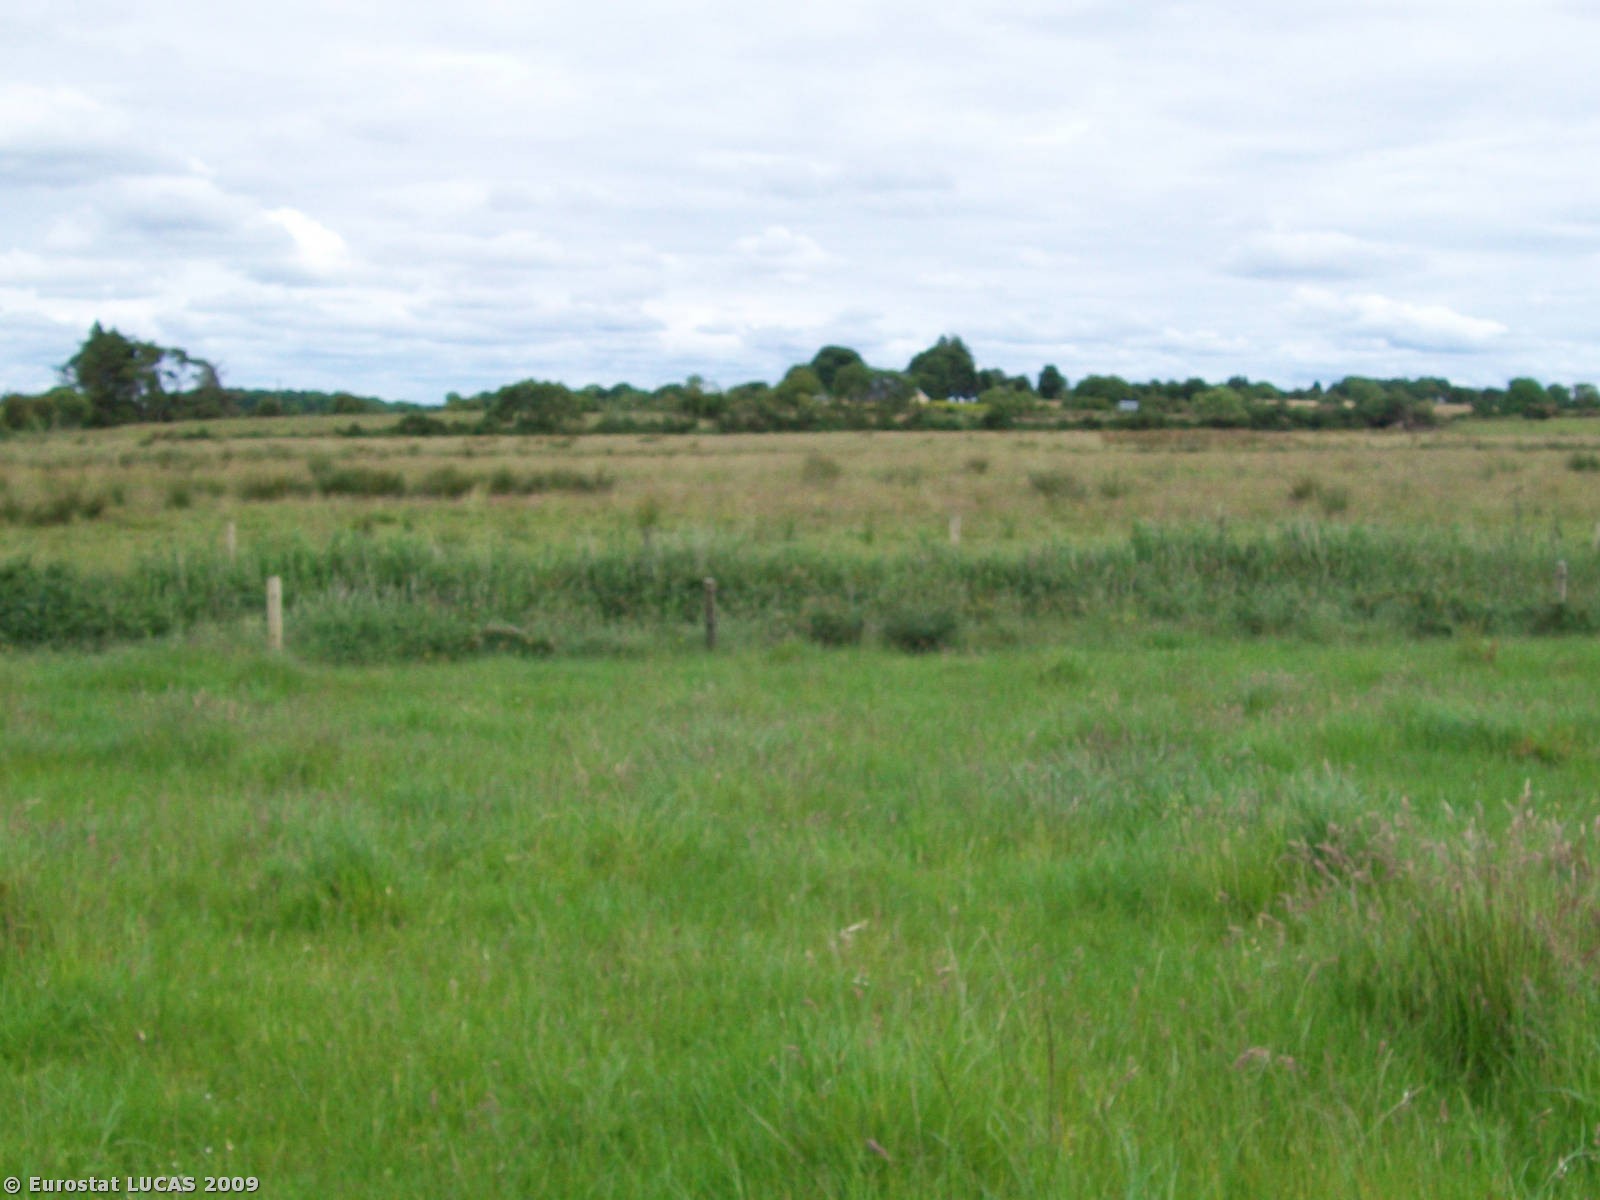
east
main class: Artificial land
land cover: Non built-up linear features
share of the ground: > 75 %
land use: Road transport
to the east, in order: Non built-up linear features; Grassland without tree/shrub cover; Fences; Ditches and canals; Fences; Grassland without tree/shrub cover; Fences; Rivers and streams; Fences; Grassland without tree/shrub cover; Fences; Grassland without tree/shrub cover
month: June
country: IE
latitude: 53.8027
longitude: -8.9942
